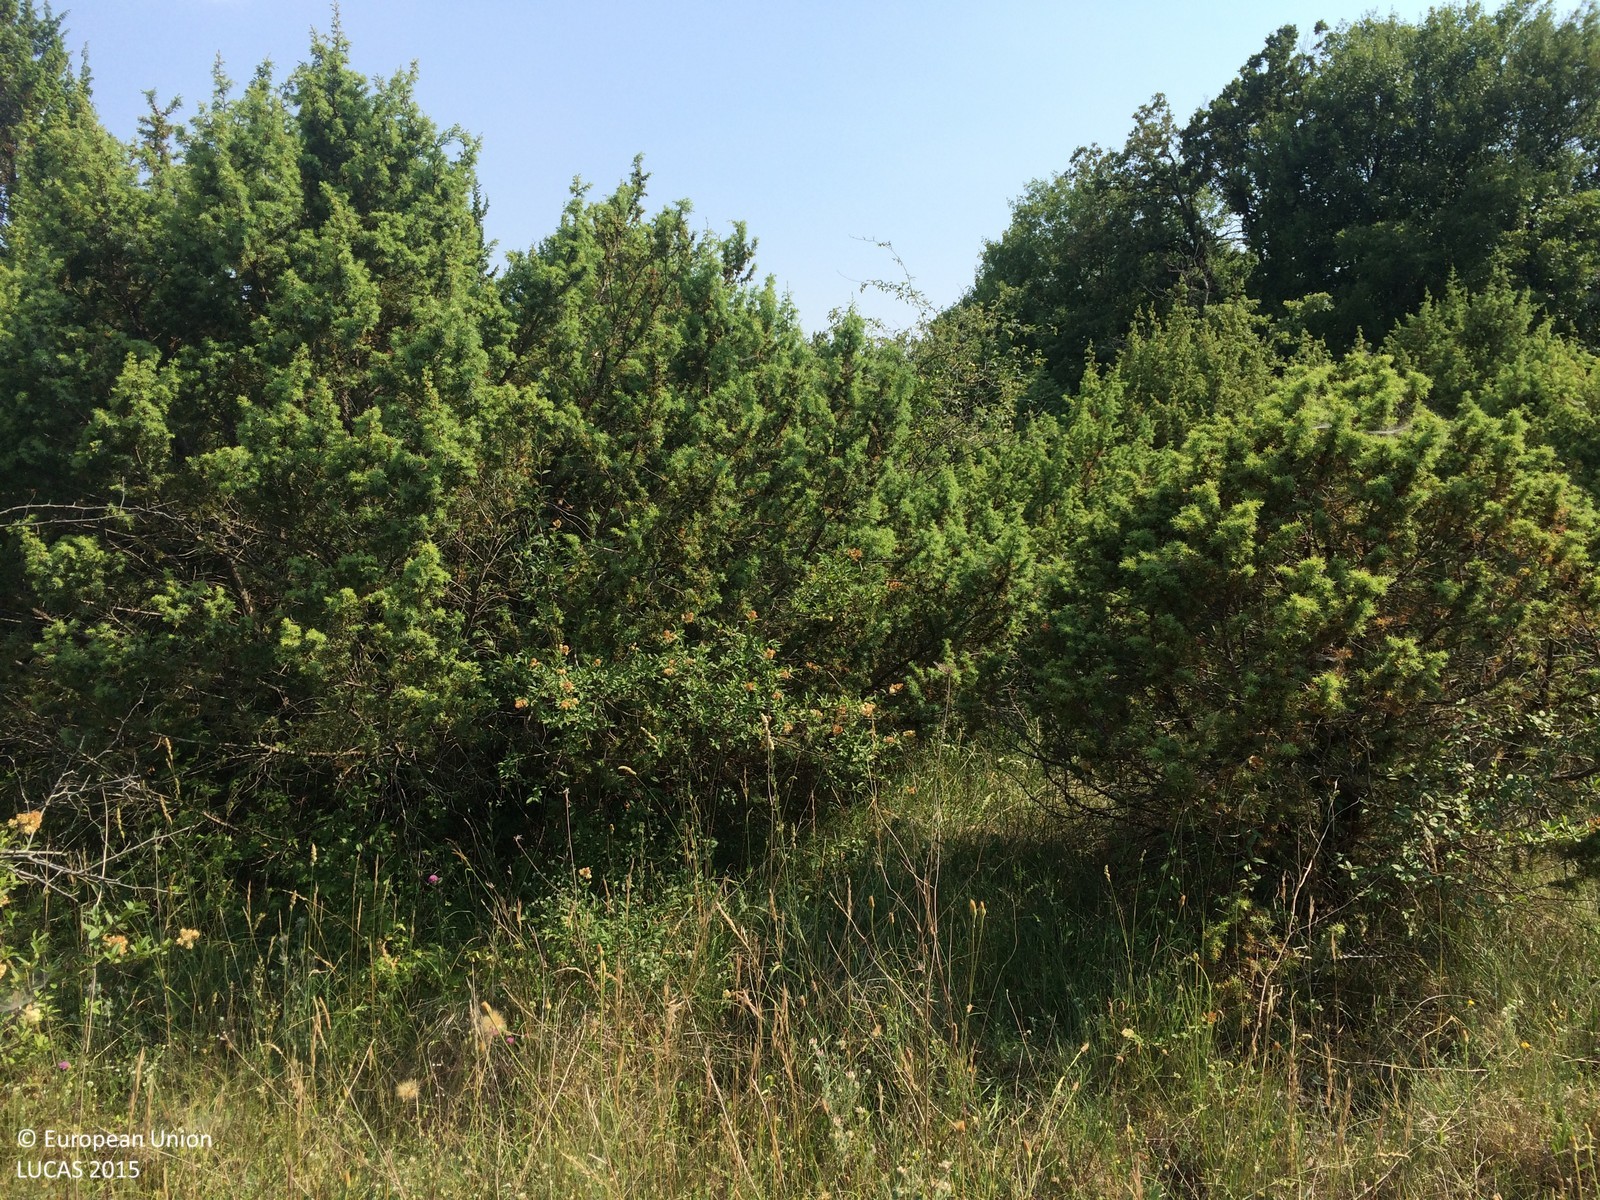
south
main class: Shrubland
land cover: Shrubland without tree cover
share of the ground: > 75 %
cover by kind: shrubs 90 %, herbaceous plants 10 %
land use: Semi-natural and natural areas not in use
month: June
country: HR
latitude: 45.0736
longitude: 13.8432
